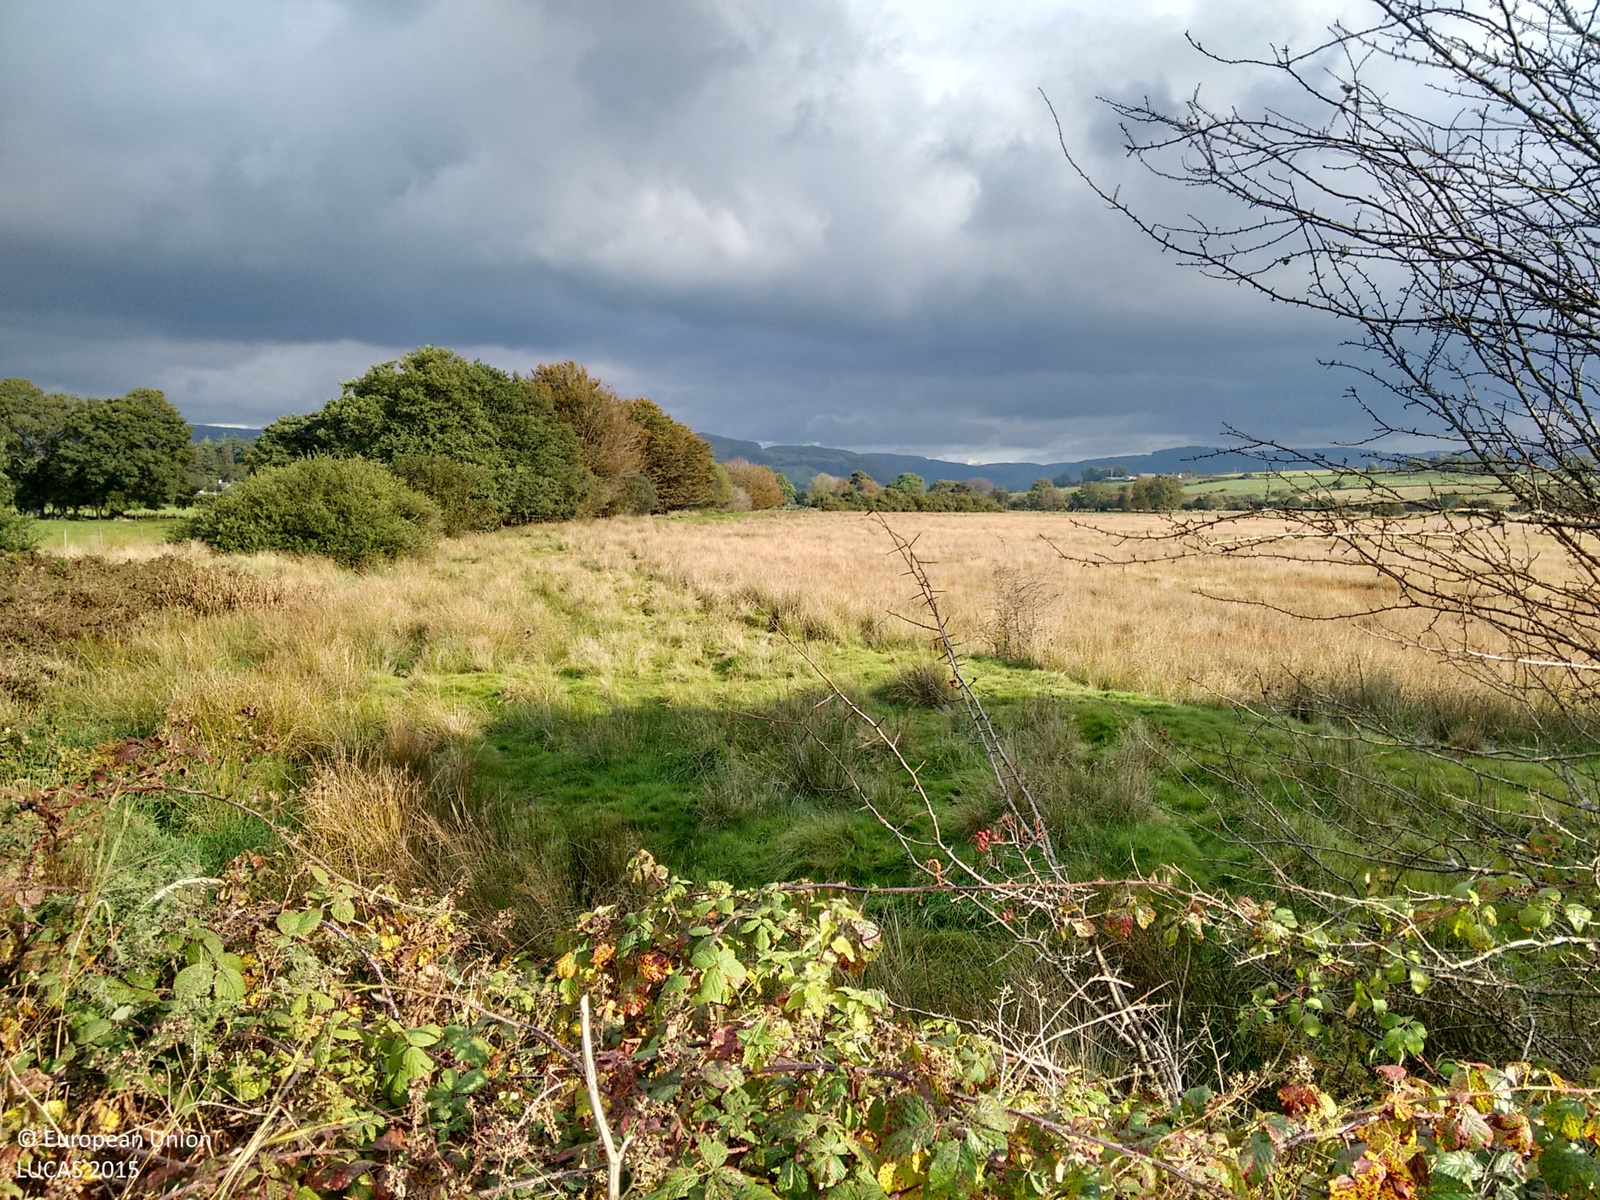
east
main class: Grassland
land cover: Grassland without tree/shrub cover
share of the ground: > 75 %
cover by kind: herbaceous plants 100 %
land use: Agriculture (excluding fallow land and kitchen gardens)
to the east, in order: Grassland without tree/shrub cover; Ditches and canals; Lines of trees; Fences; Grassland without tree/shrub cover; Fences; Grassland without tree/shrub cover; Fences; Grassland without tree/shrub cover
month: October
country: GB
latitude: 52.2861
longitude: -3.8869
